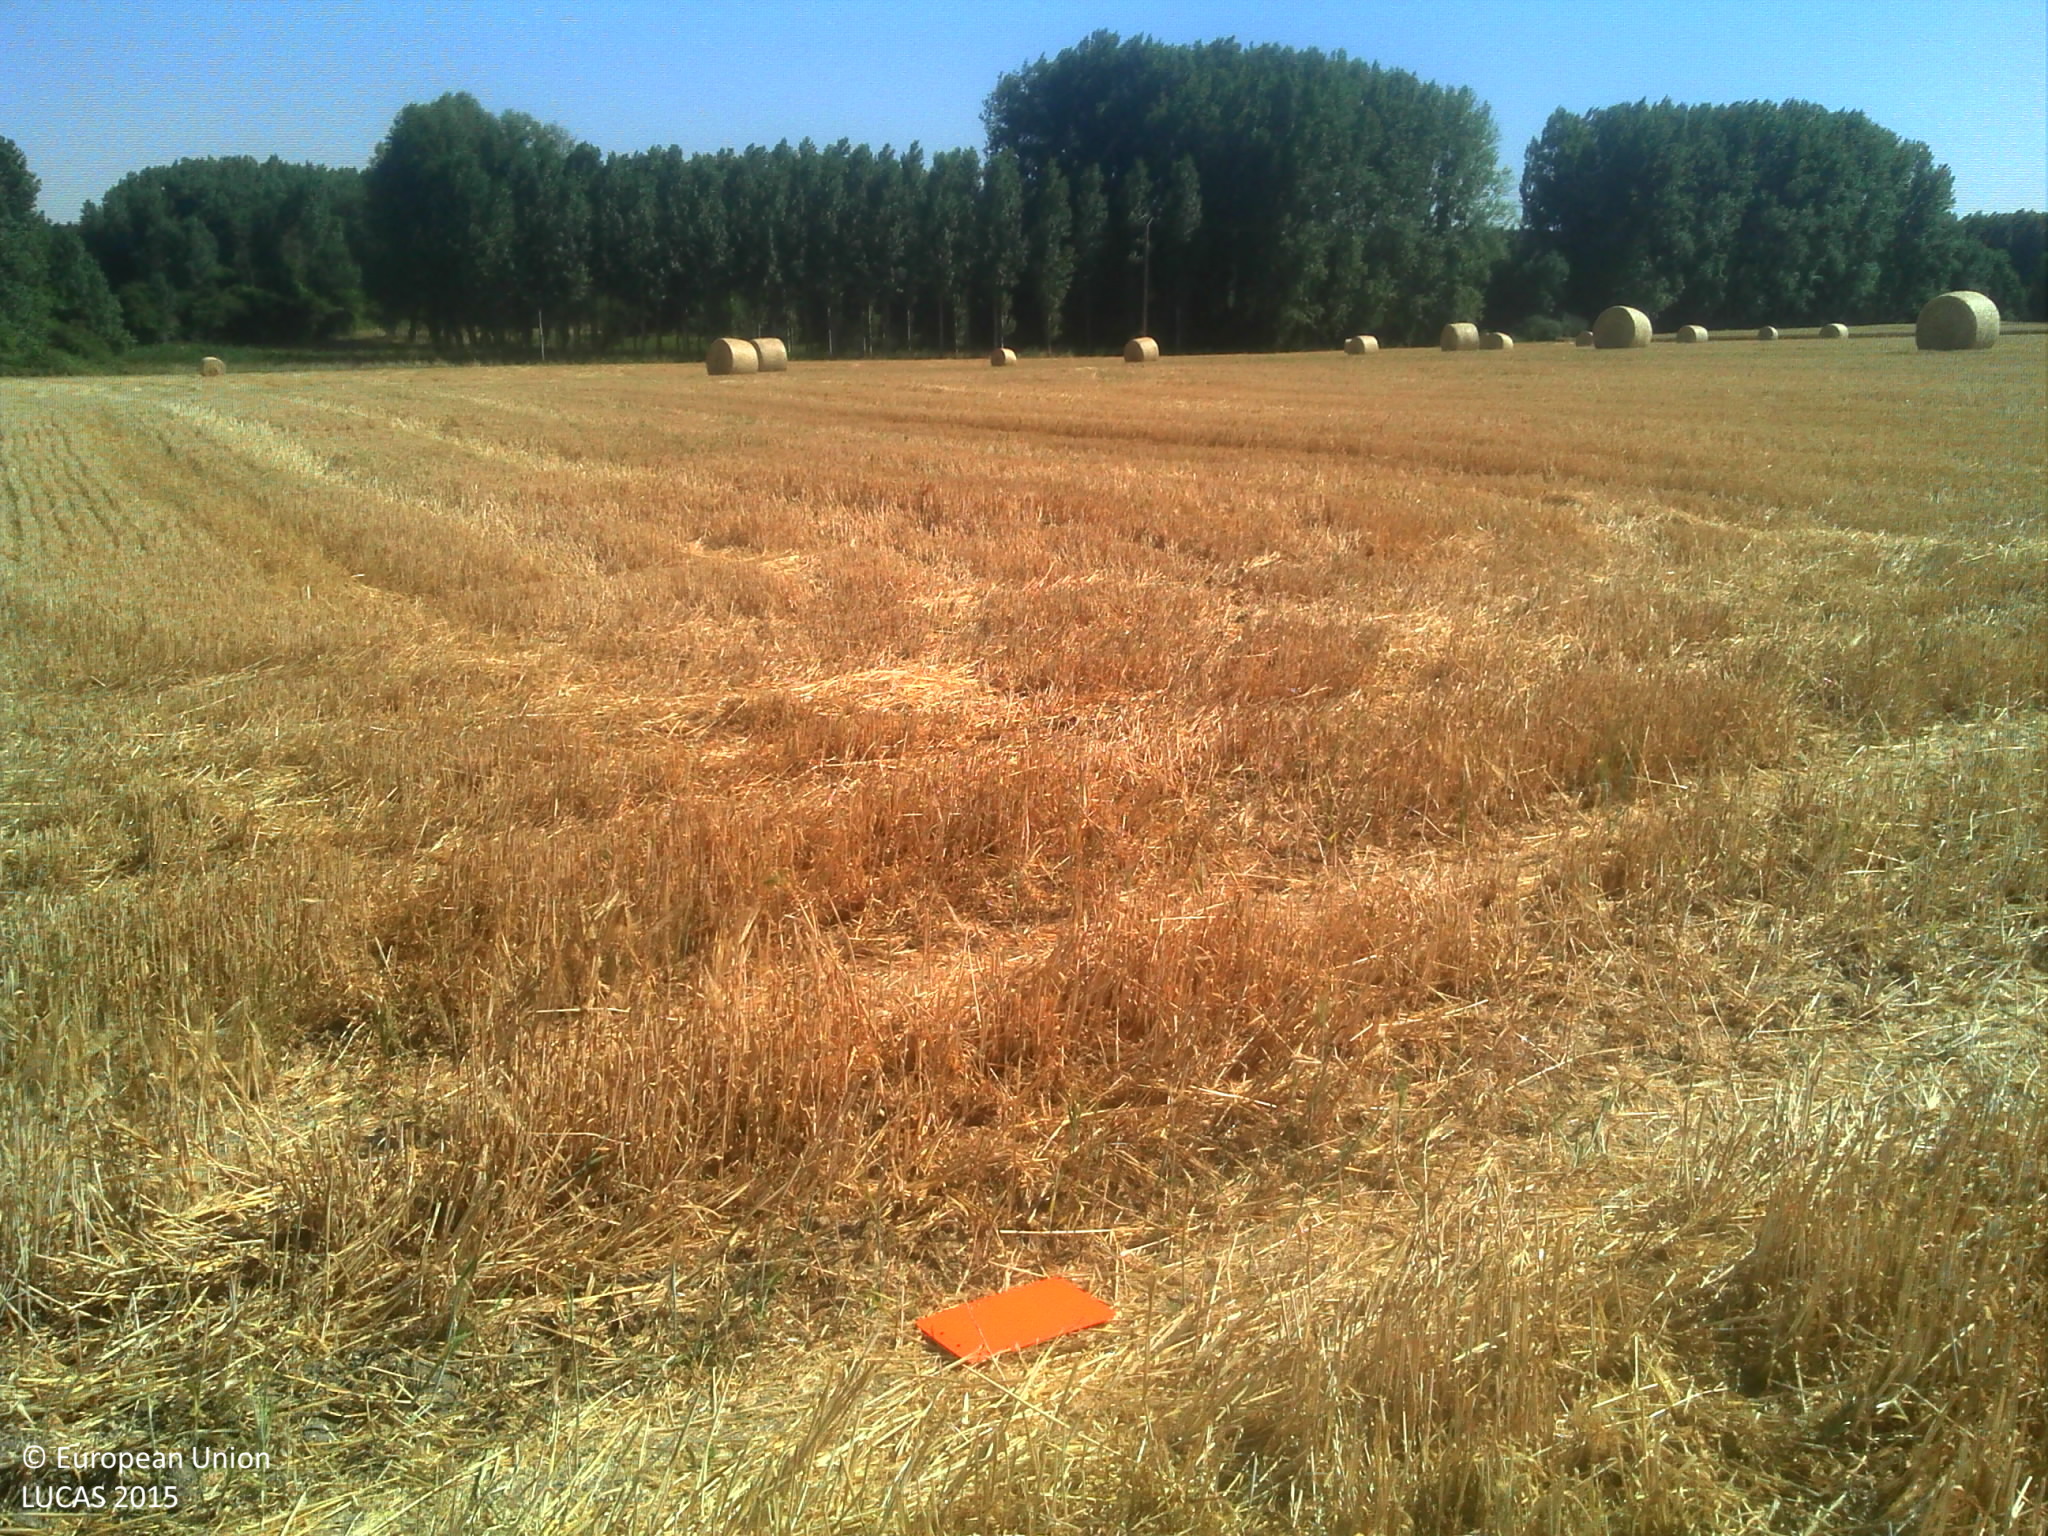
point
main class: Cropland
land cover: Barley
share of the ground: > 75 %
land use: Agriculture (excluding fallow land and kitchen gardens)
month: June
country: FR
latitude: 47.3300
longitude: 1.4513
